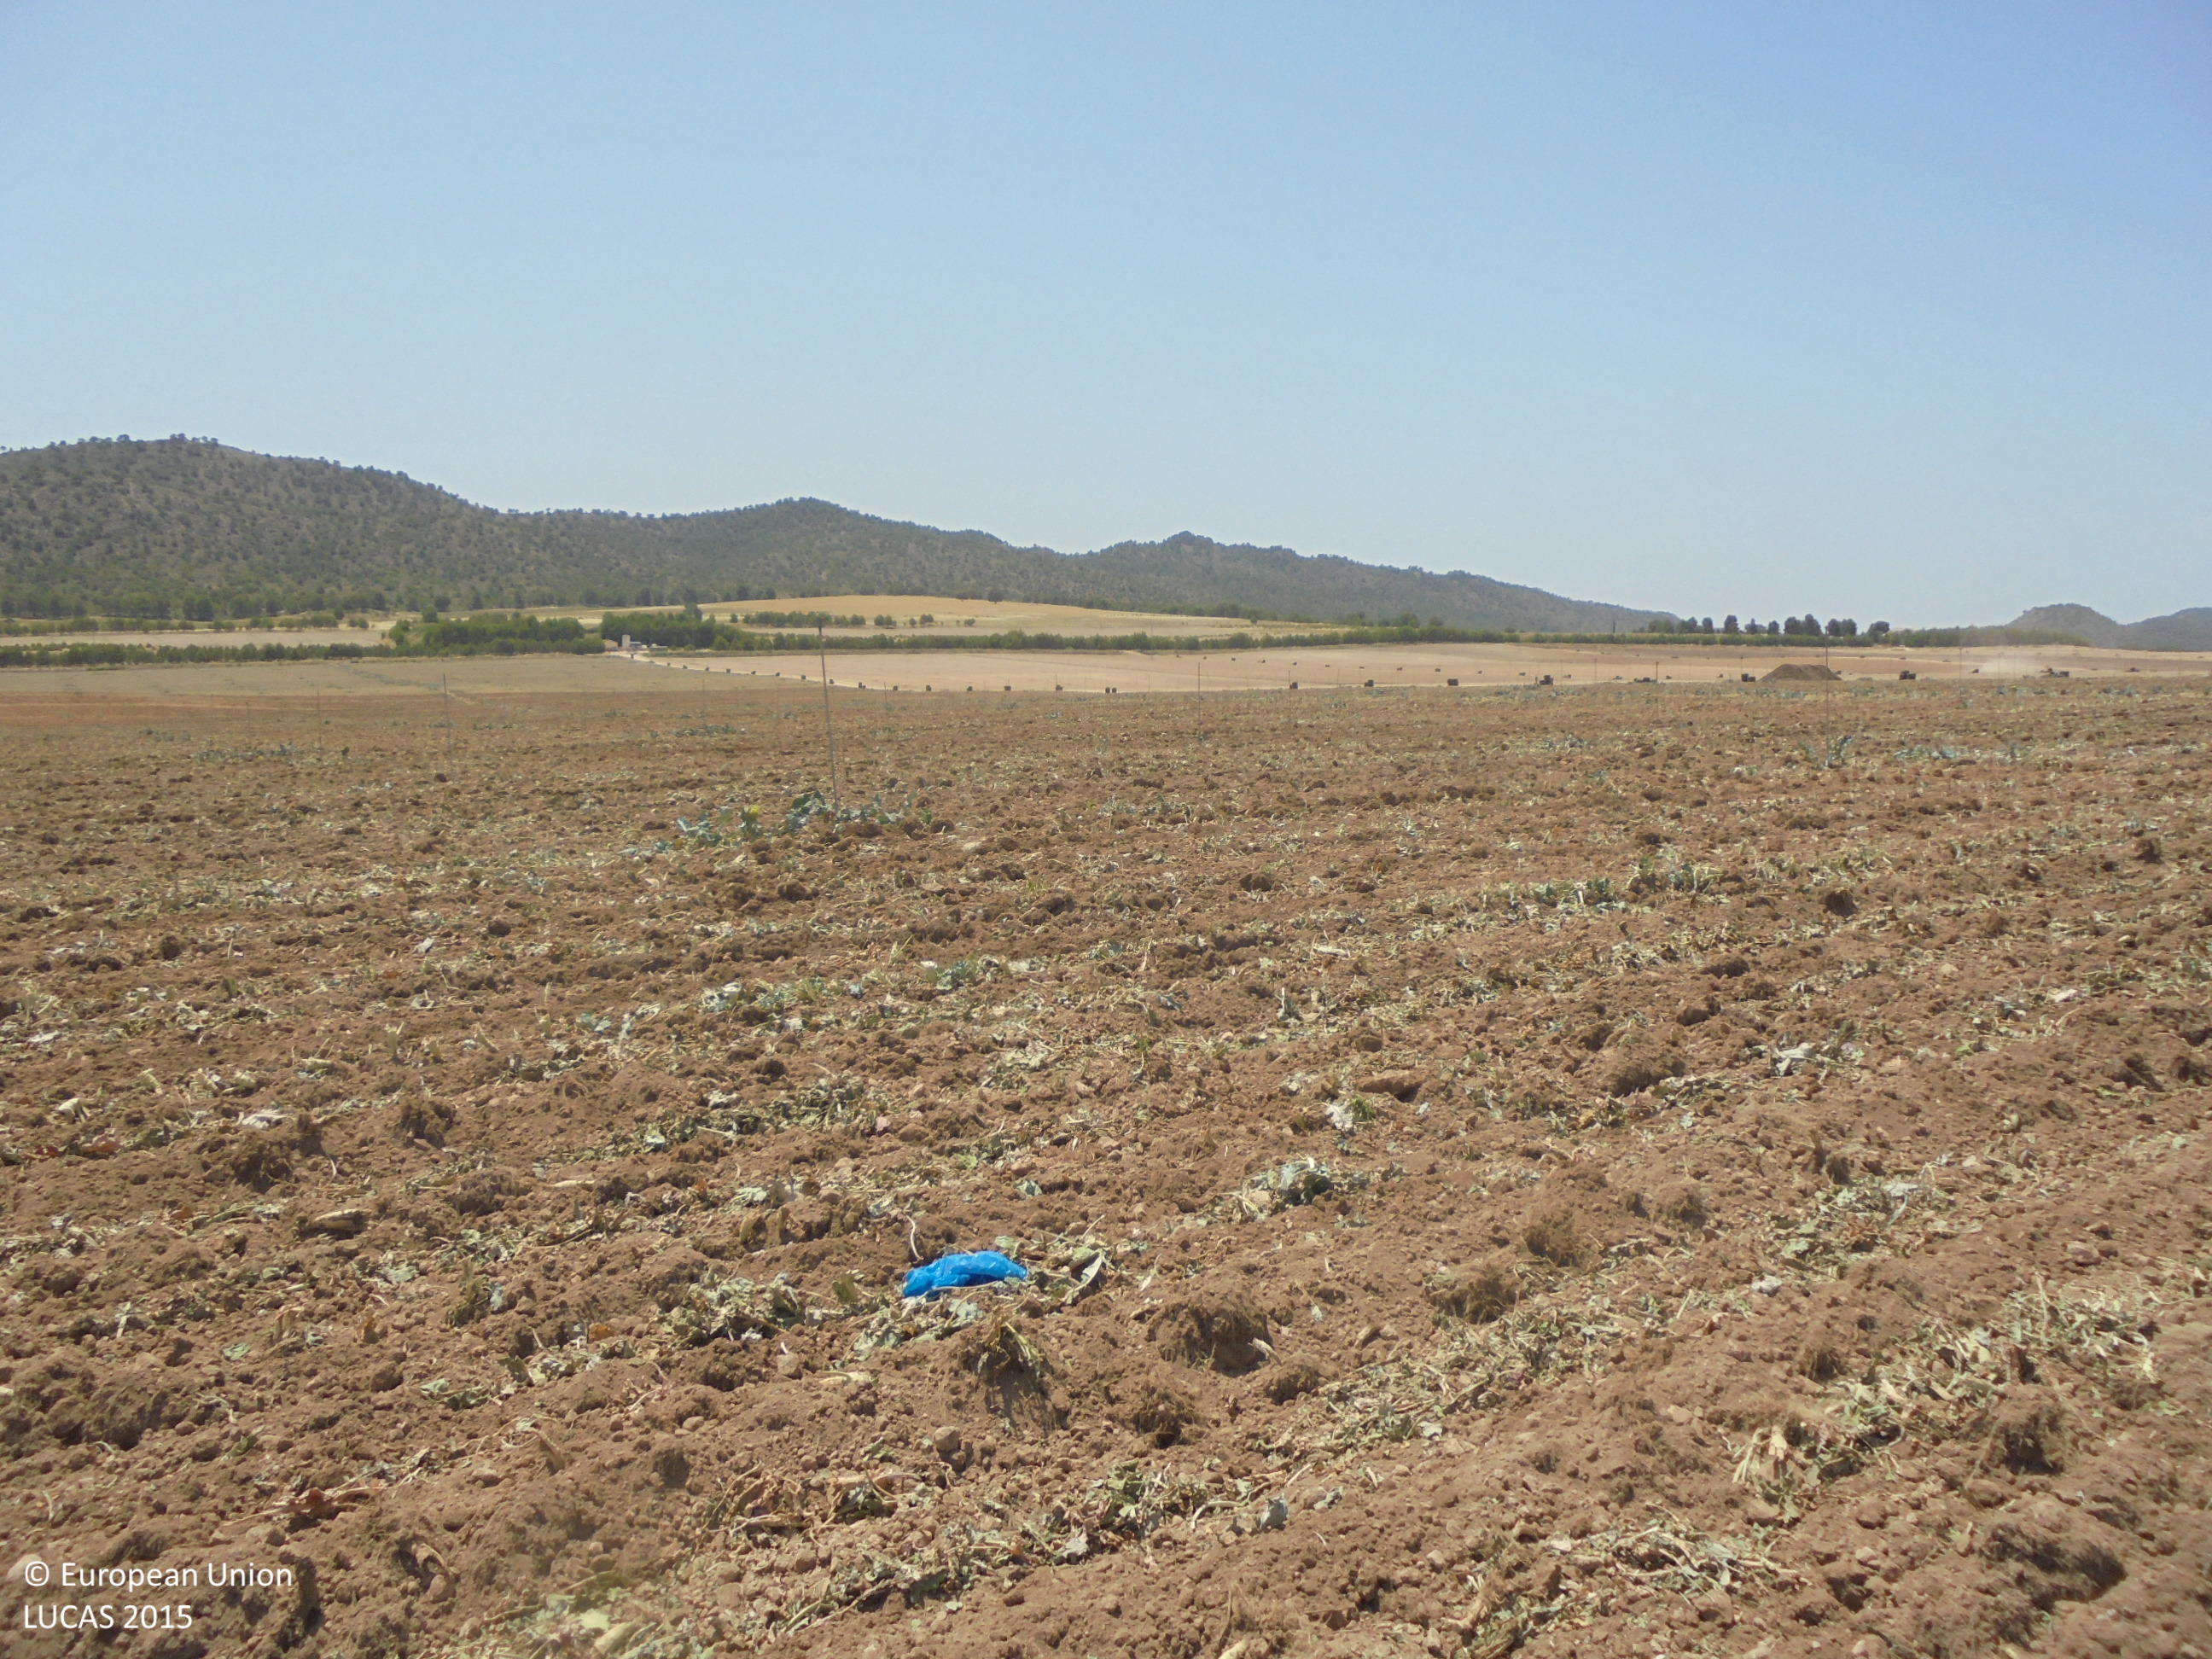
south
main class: Cropland
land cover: Other fresh vegetables
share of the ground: < 10 %
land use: Agriculture (excluding fallow land and kitchen gardens)
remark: Harvested field
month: July
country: ES
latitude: 38.6712
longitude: -1.6843
